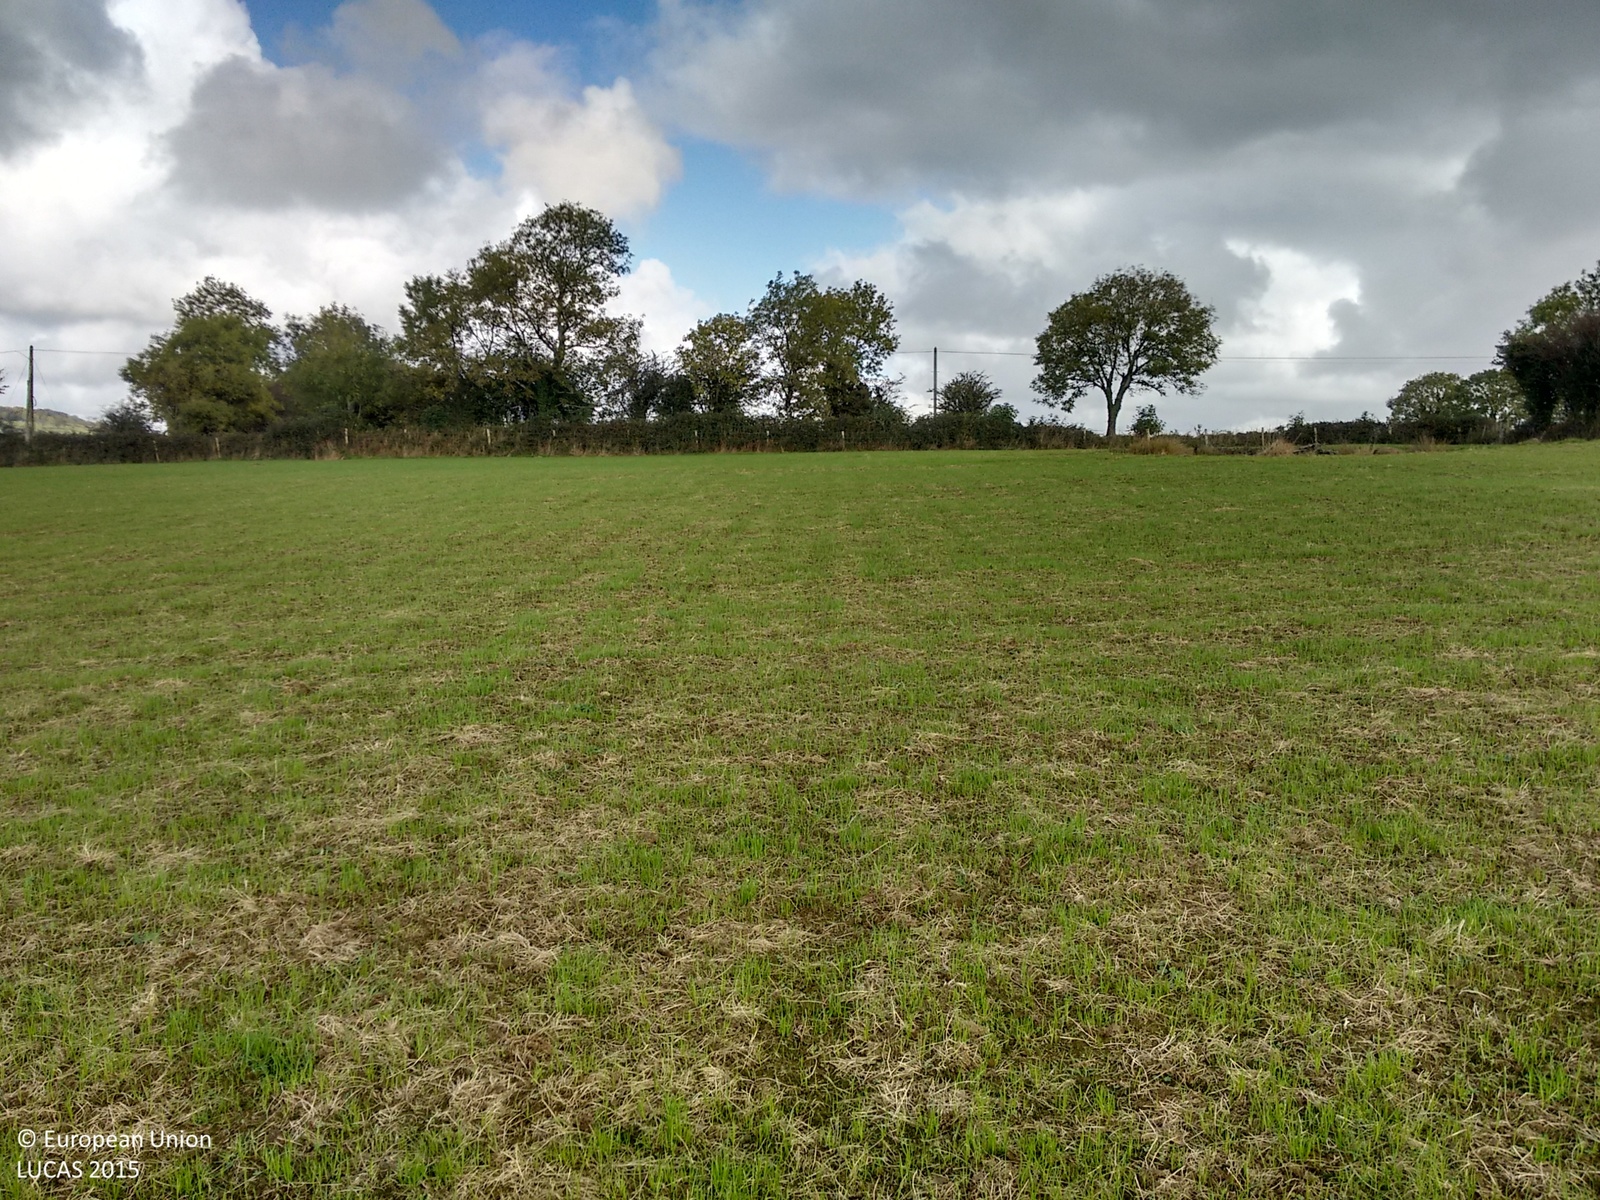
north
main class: Grassland
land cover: Grassland without tree/shrub cover
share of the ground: > 75 %
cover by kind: herbaceous plants 85 %, unconsolidated bare surface 10 %
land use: Agriculture (excluding fallow land and kitchen gardens)
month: October
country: IE
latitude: 53.7794
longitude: -8.0690
